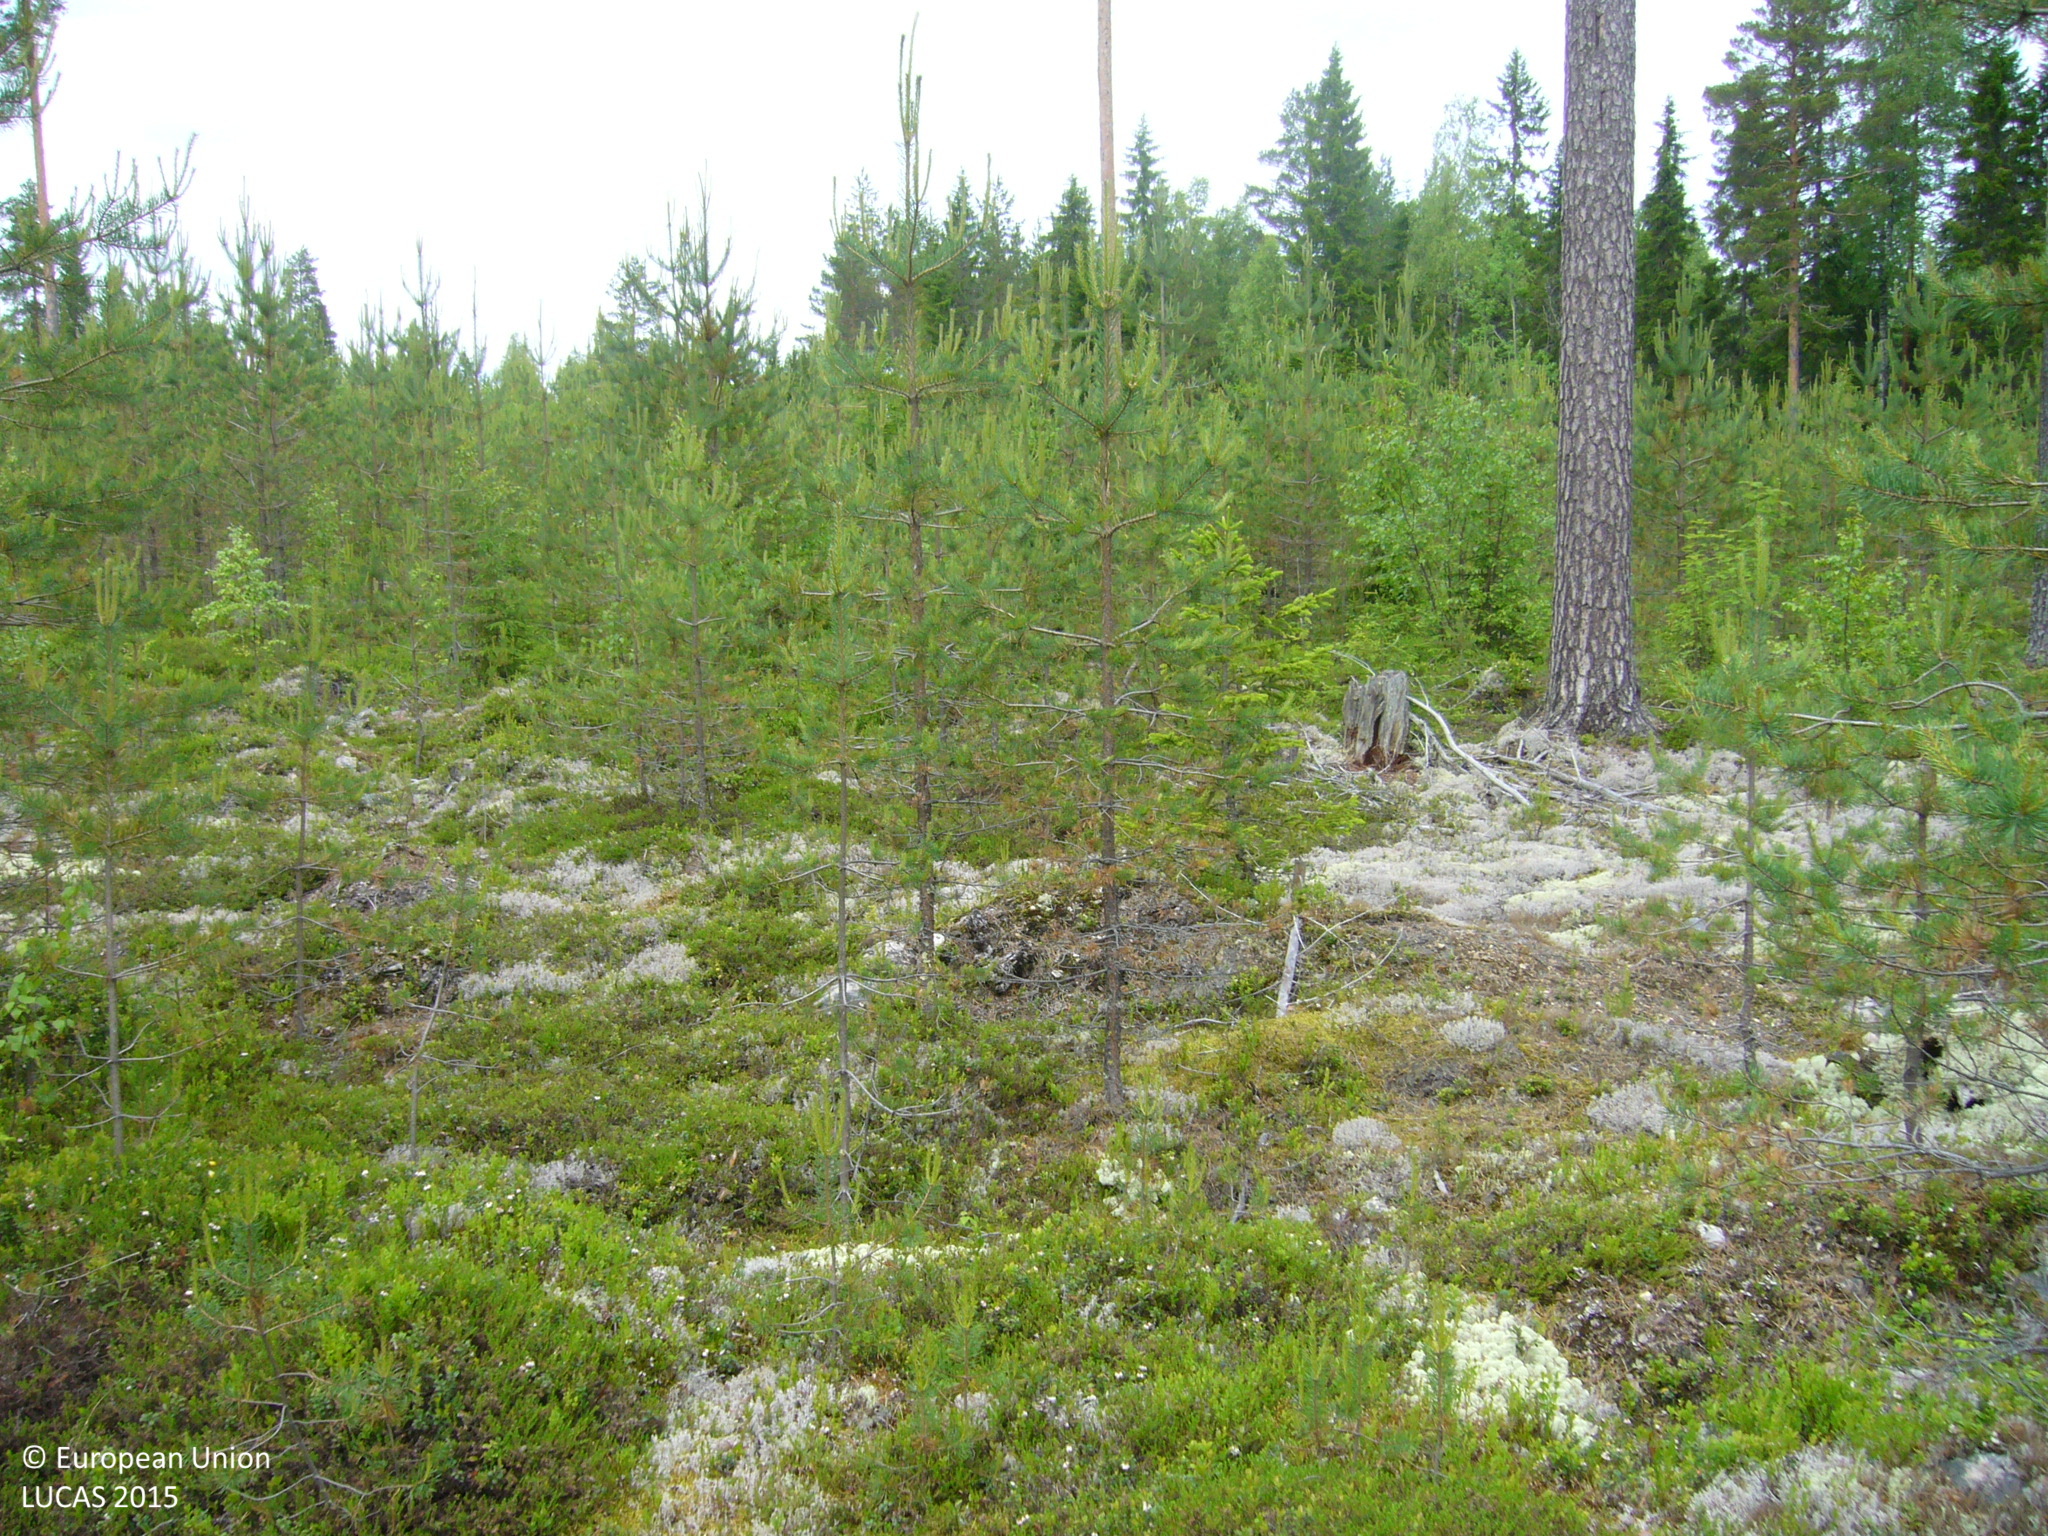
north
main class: Woodland
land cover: Pine dominated coniferous woodland
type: boreal forest
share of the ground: 50 - 75 %
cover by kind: coniferous forest trees 50 %, lichens and mosses 40 %, shrubs 10 %
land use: Forestry
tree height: > 5 m
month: July
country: FI
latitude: 63.4349
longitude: 26.1314
